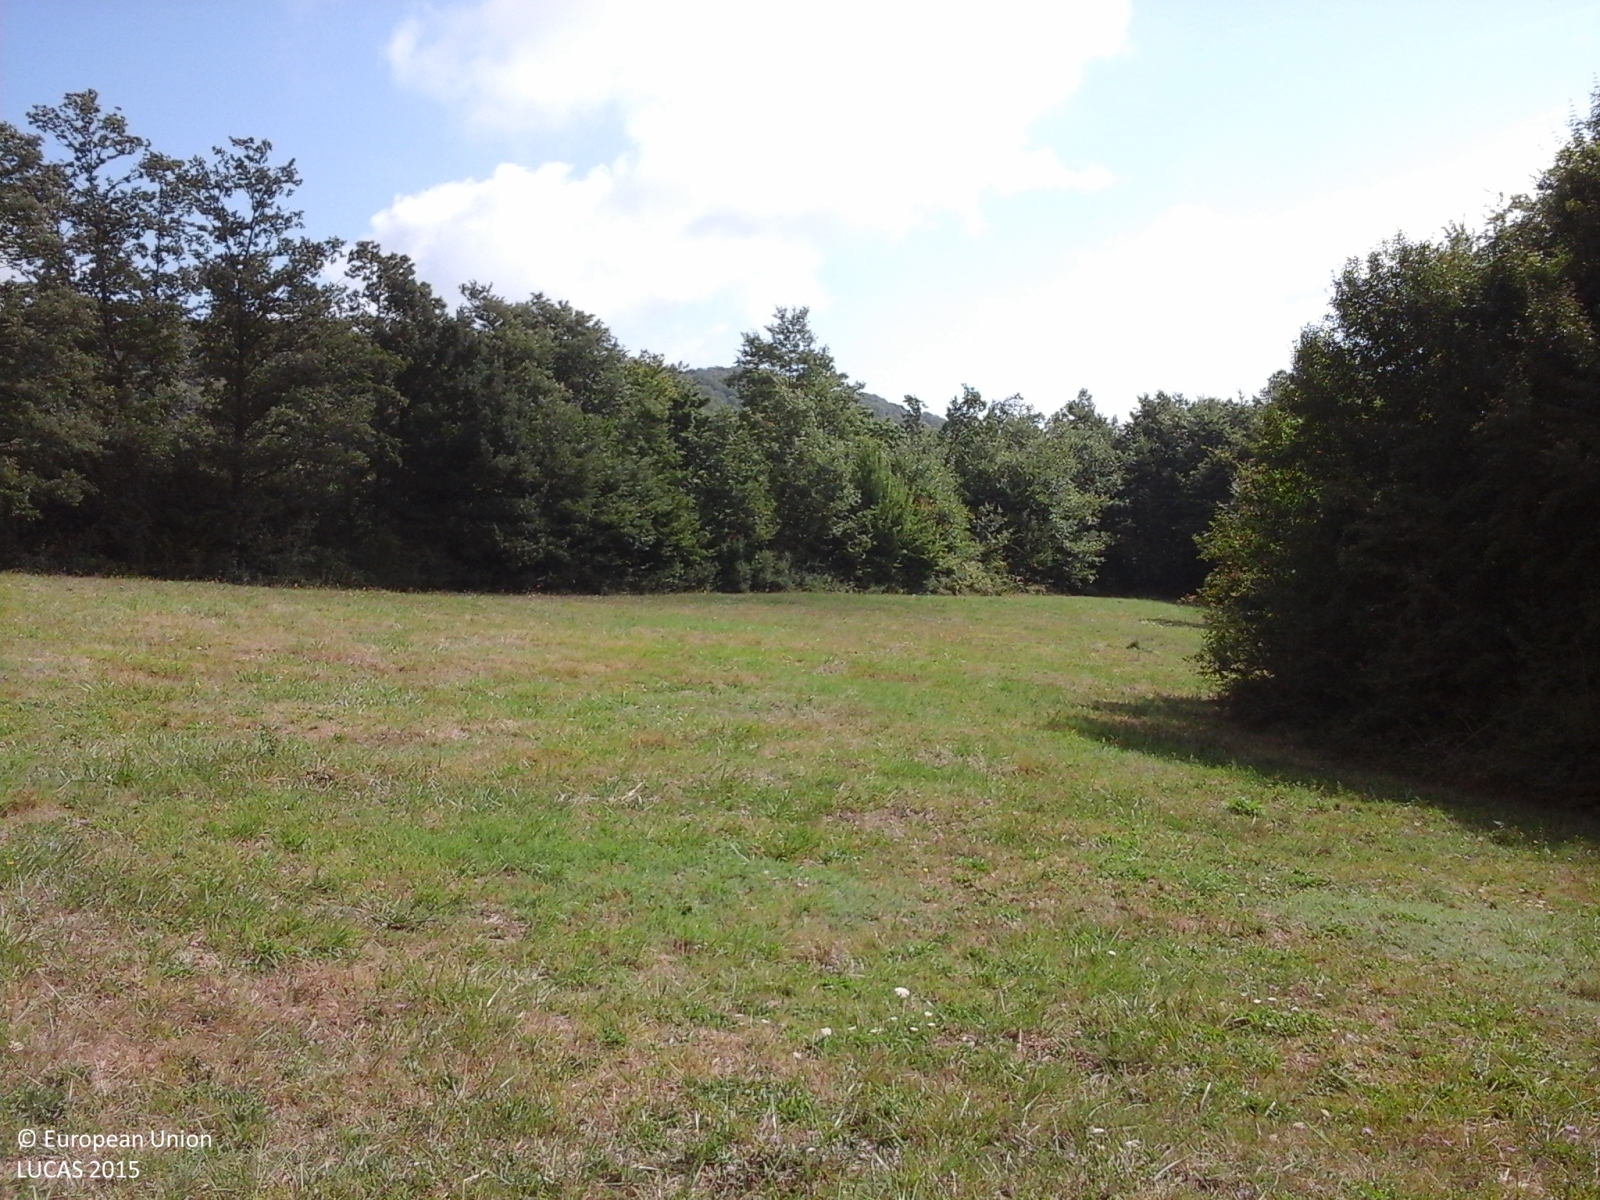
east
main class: Grassland
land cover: Grassland without tree/shrub cover
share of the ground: > 75 %
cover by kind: herbaceous plants 100 %
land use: Agriculture (excluding fallow land and kitchen gardens)
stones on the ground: < 10 %
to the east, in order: Grassland without tree/shrub cover; Broadleaved woodland
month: August
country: IT
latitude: 41.7496
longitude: 14.2784
